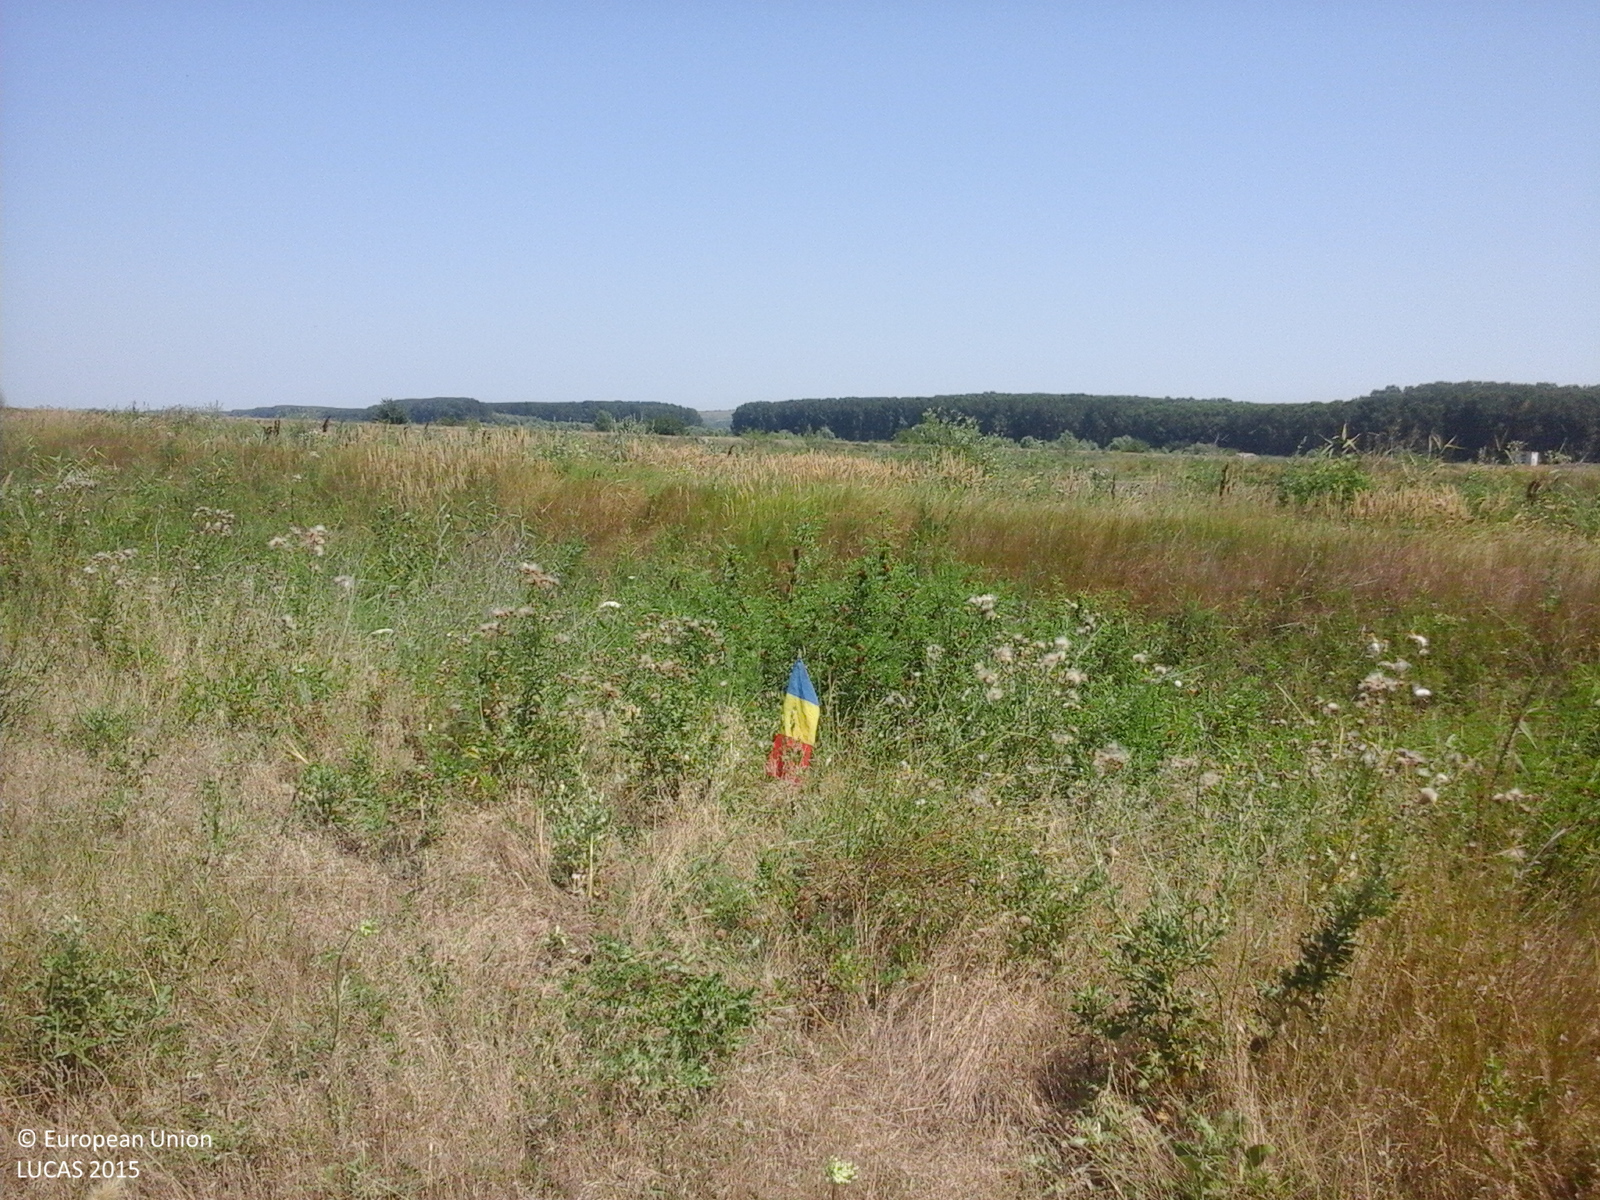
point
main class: Grassland
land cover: Spontaneously vegetated surfaces
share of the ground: > 75 %
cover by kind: herbaceous plants 100 %
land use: Semi-natural and natural areas not in use
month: July
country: RO
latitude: 44.1602
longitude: 27.4824
